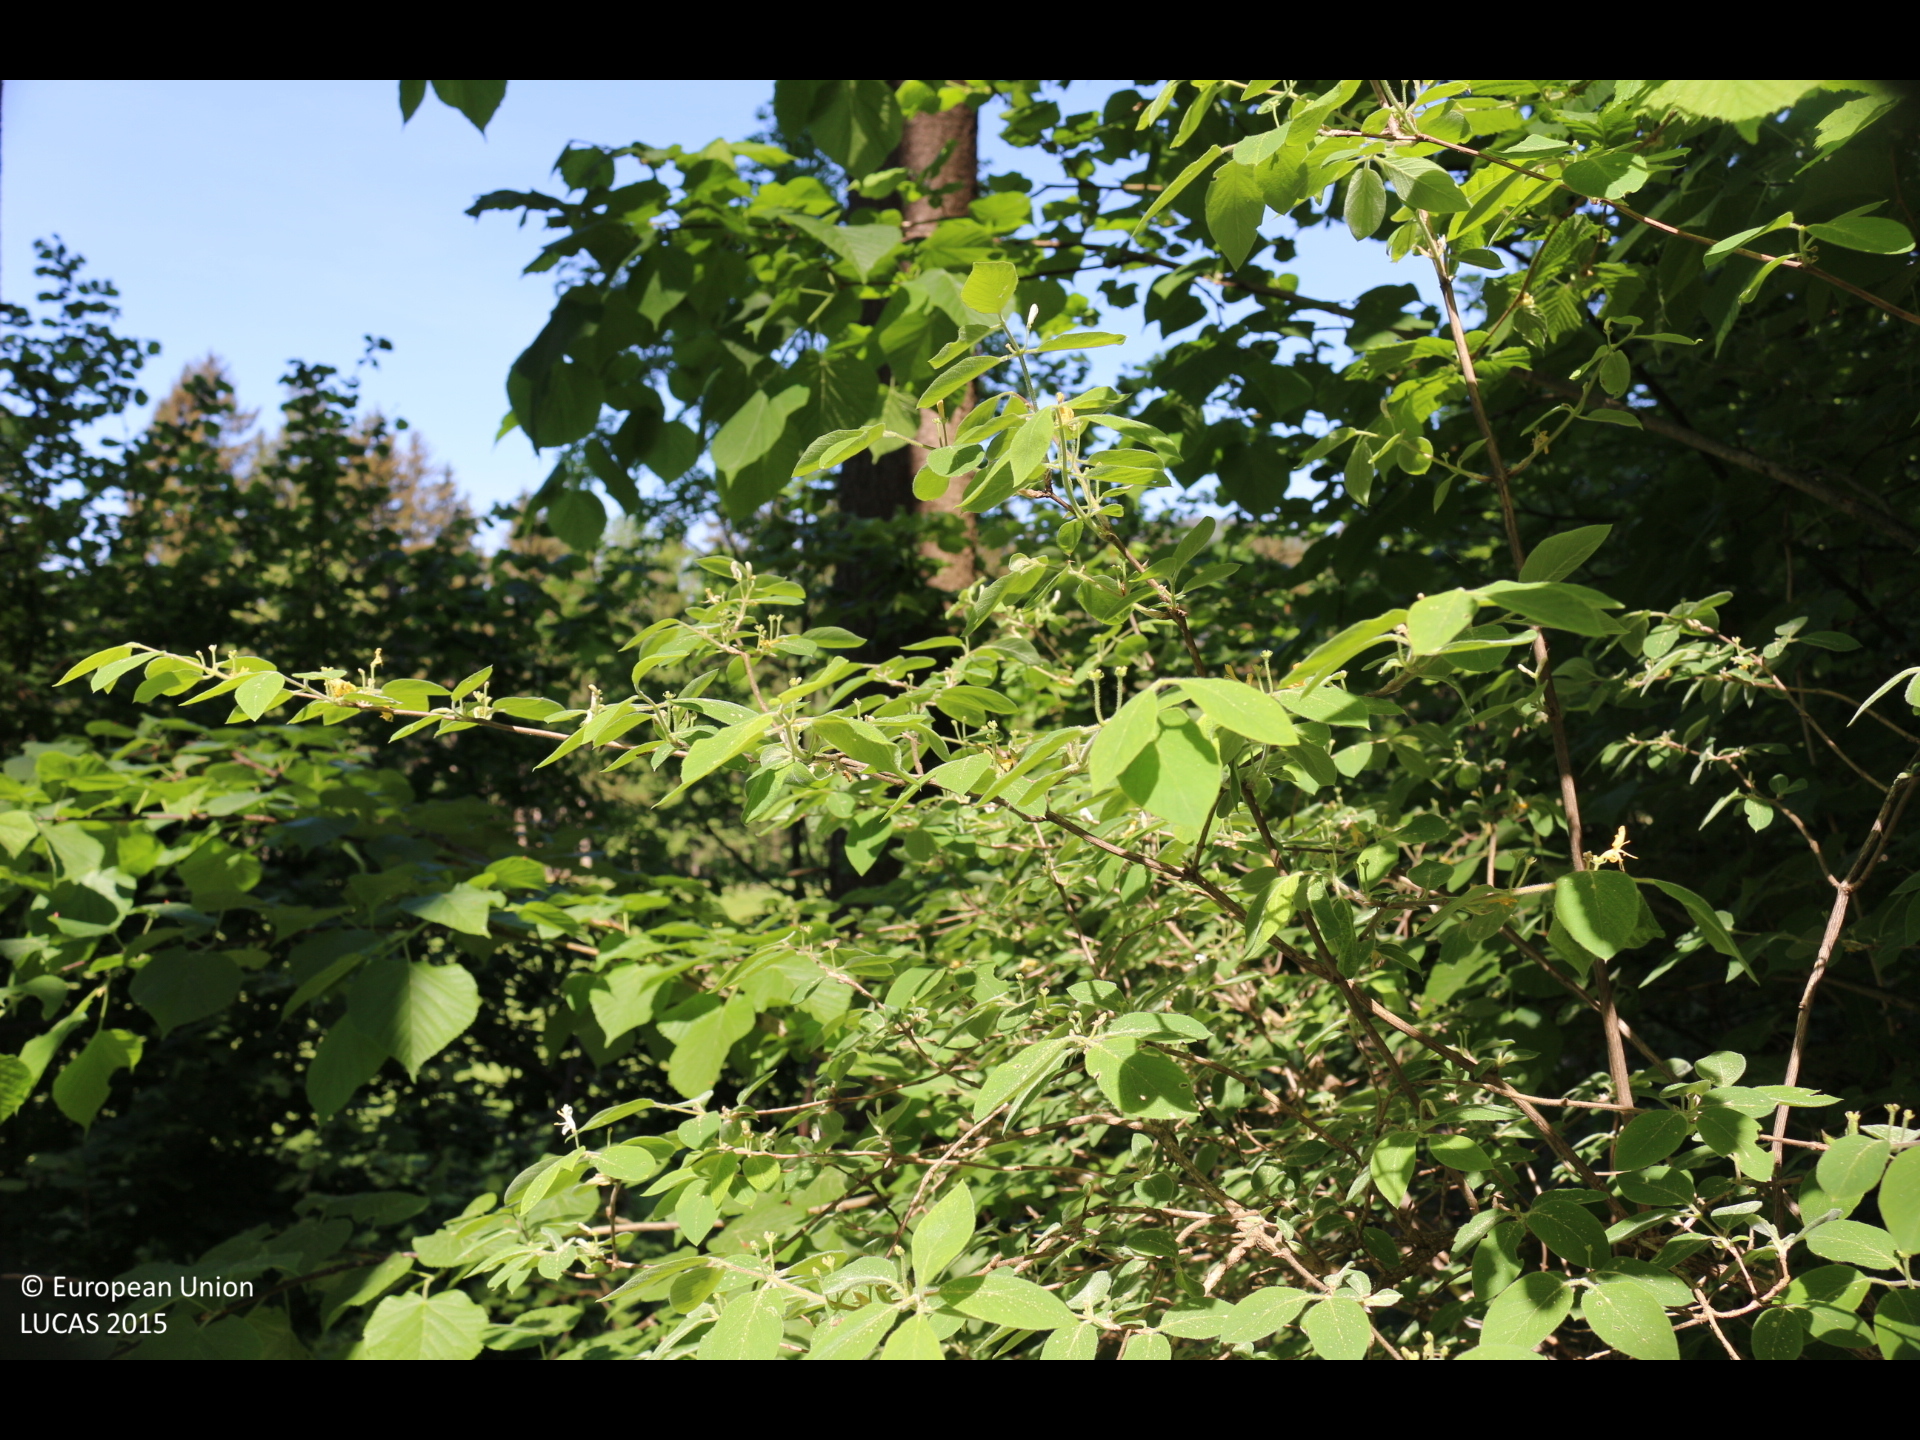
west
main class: Woodland
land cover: Spruce dominated coniferous woodland
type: alpine coniferous forest
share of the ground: > 75 %
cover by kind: coniferous forest trees 70 %, broadleaved forest trees 20 %, shrubs 10 %
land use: Forestry
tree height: > 5 m
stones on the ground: < 10 %
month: May
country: AT
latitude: 46.7864
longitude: 14.3336
